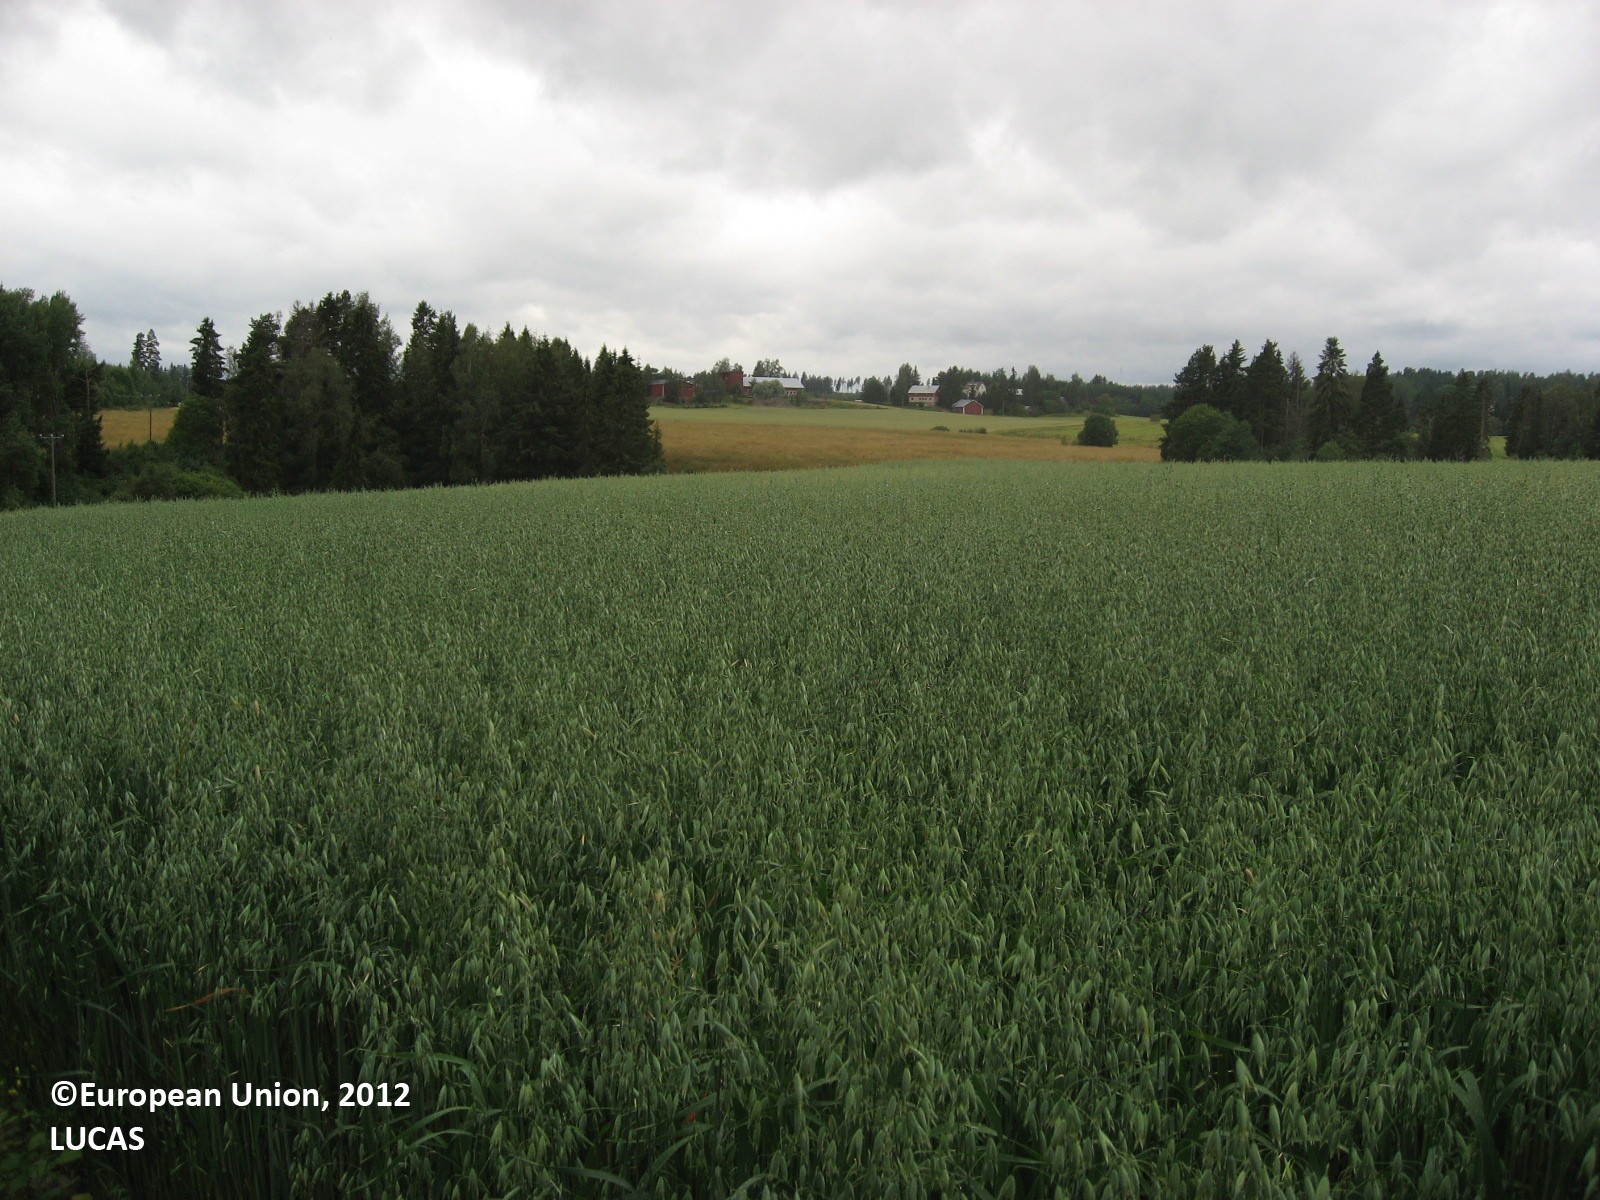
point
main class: Cropland
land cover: Oats
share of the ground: > 75 %
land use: Agriculture (excluding fallow land and kitchen gardens)
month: August
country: FI
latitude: 60.6191
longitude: 25.5330
